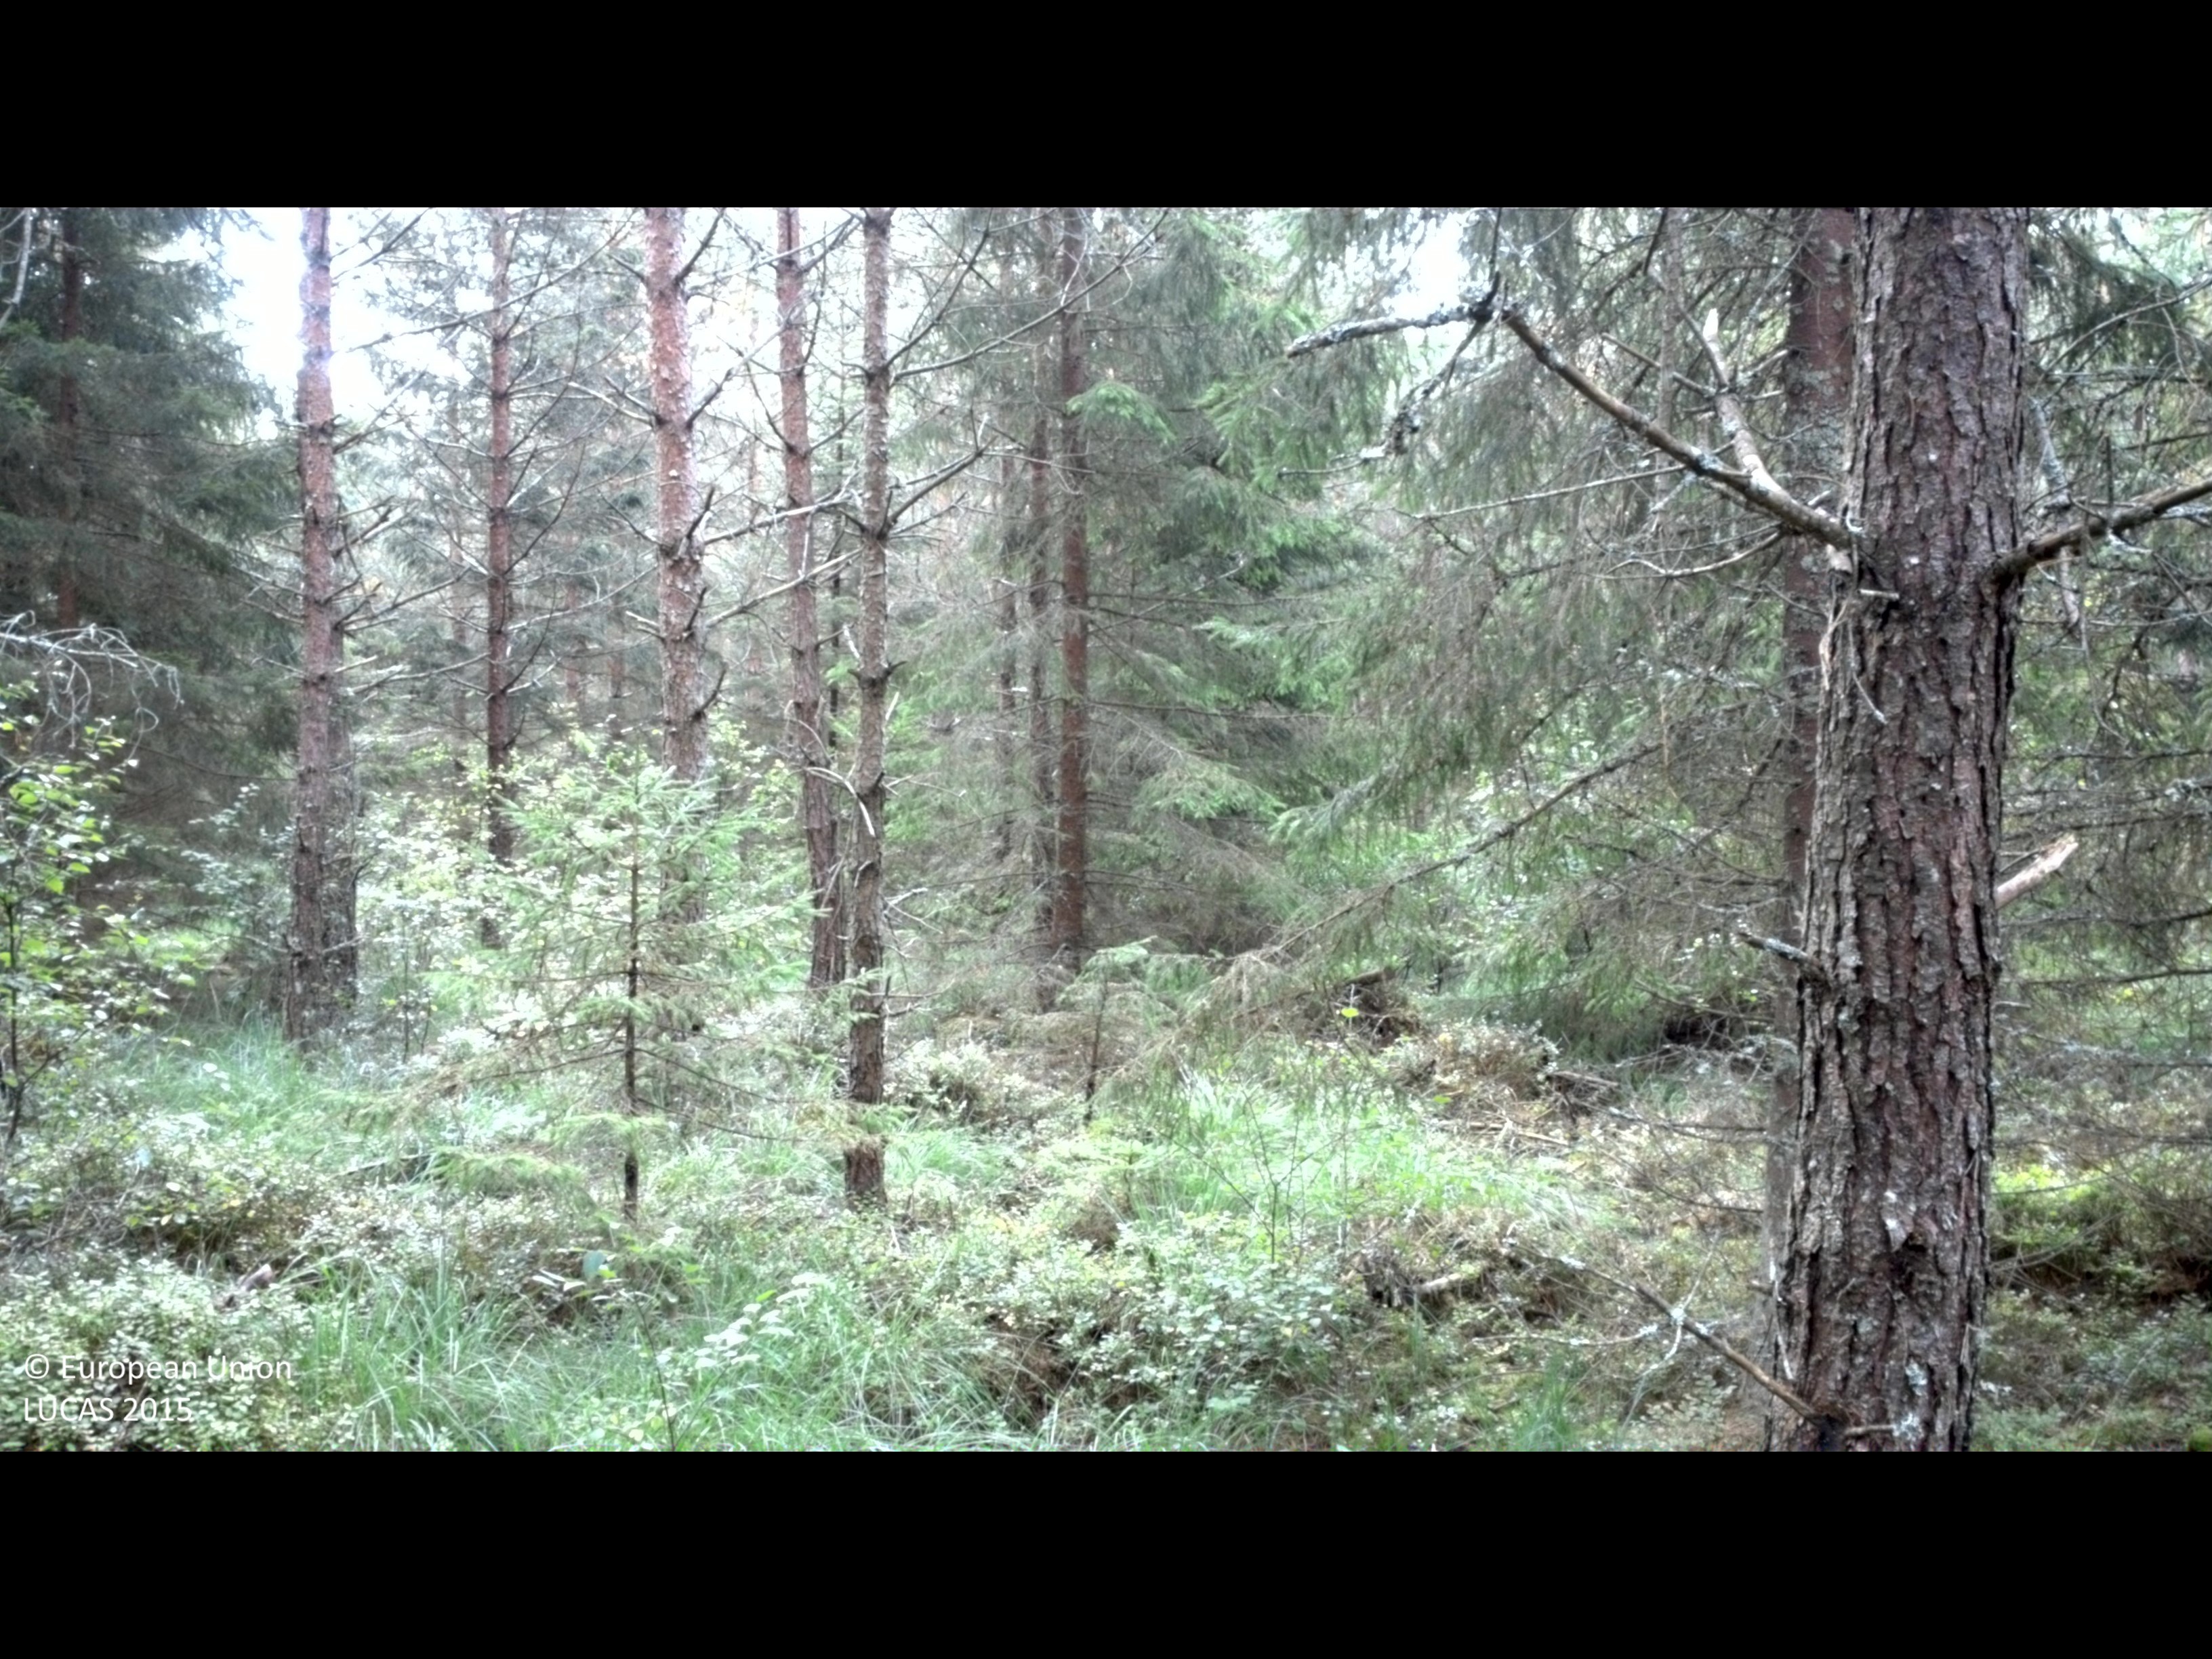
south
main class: Woodland
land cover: Pine dominated coniferous woodland
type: boreal forest
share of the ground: 50 - 75 %
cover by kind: coniferous forest trees 60 %, shrubs 20 %, herbaceous plants 15 %, broadleaved forest trees 5 %
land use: Forestry
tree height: > 5 m
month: August
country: SE
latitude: 57.1392
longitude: 13.8132
